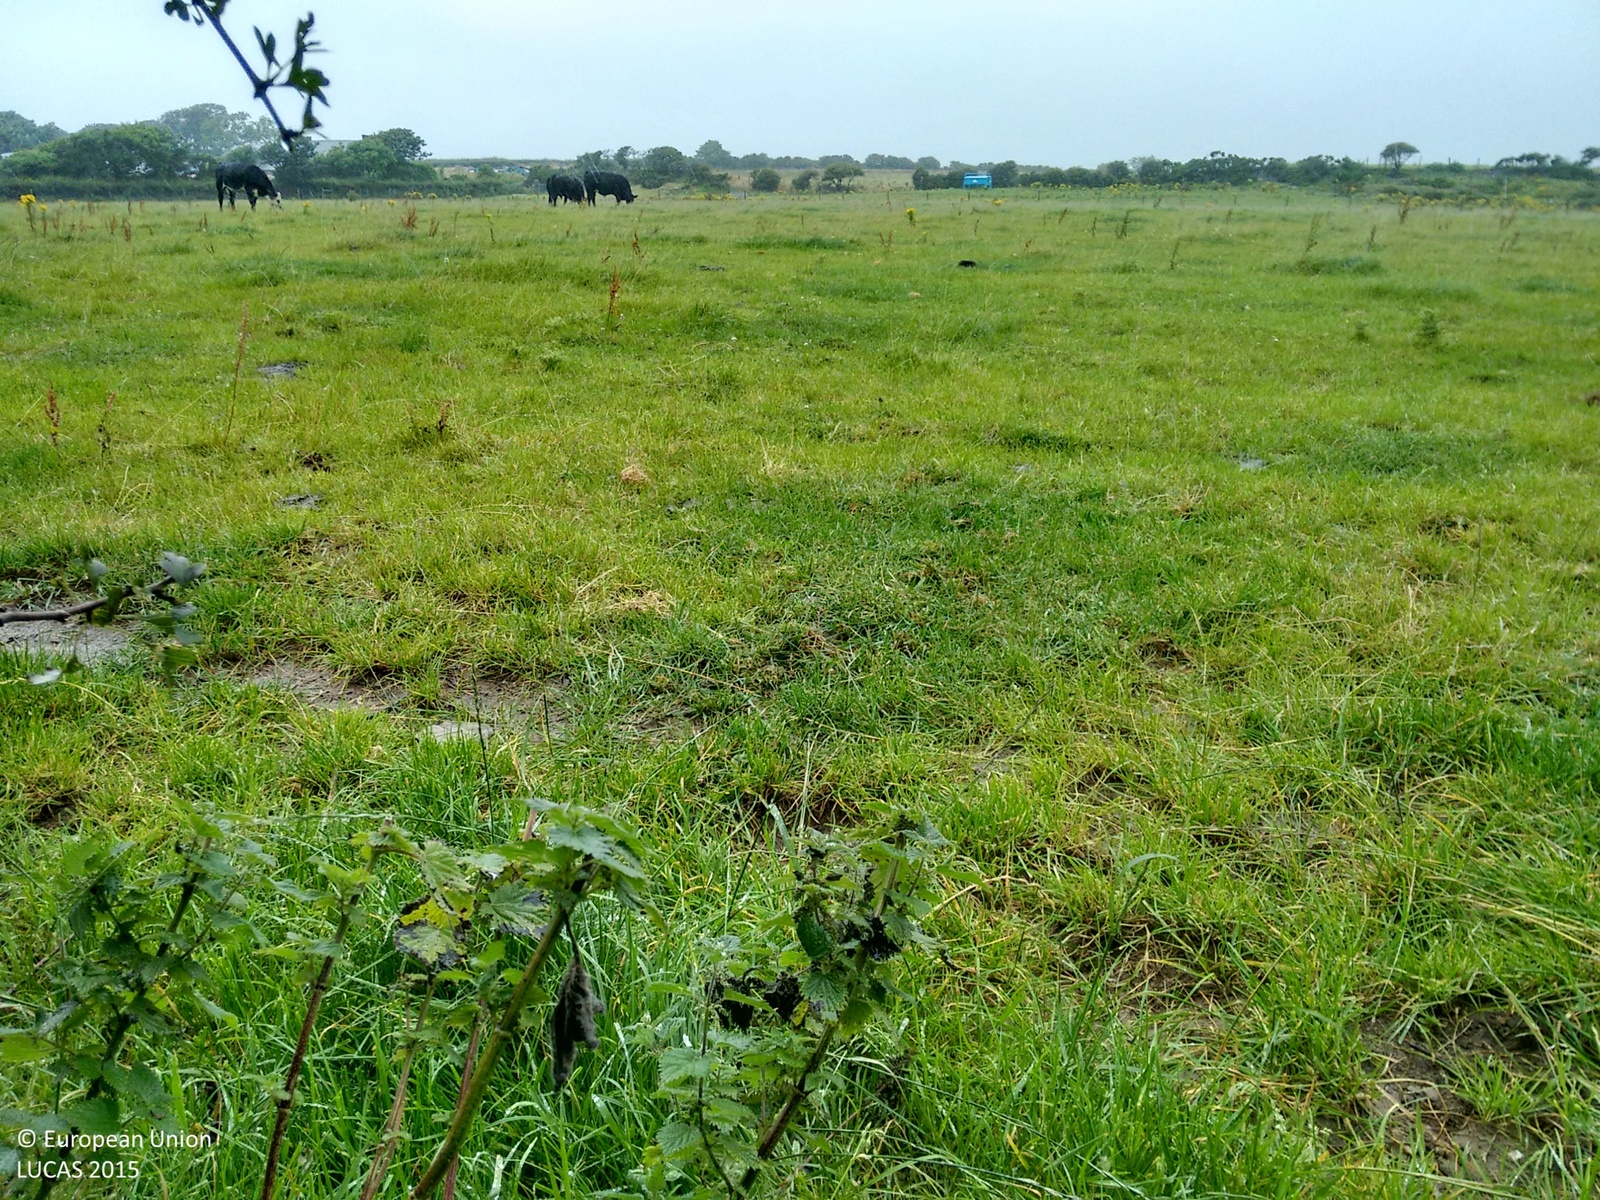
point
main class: Grassland
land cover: Grassland without tree/shrub cover
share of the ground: > 75 %
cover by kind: herbaceous plants 100 %
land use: Agriculture (excluding fallow land and kitchen gardens)
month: August
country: GB
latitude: 54.2716
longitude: -5.5936
